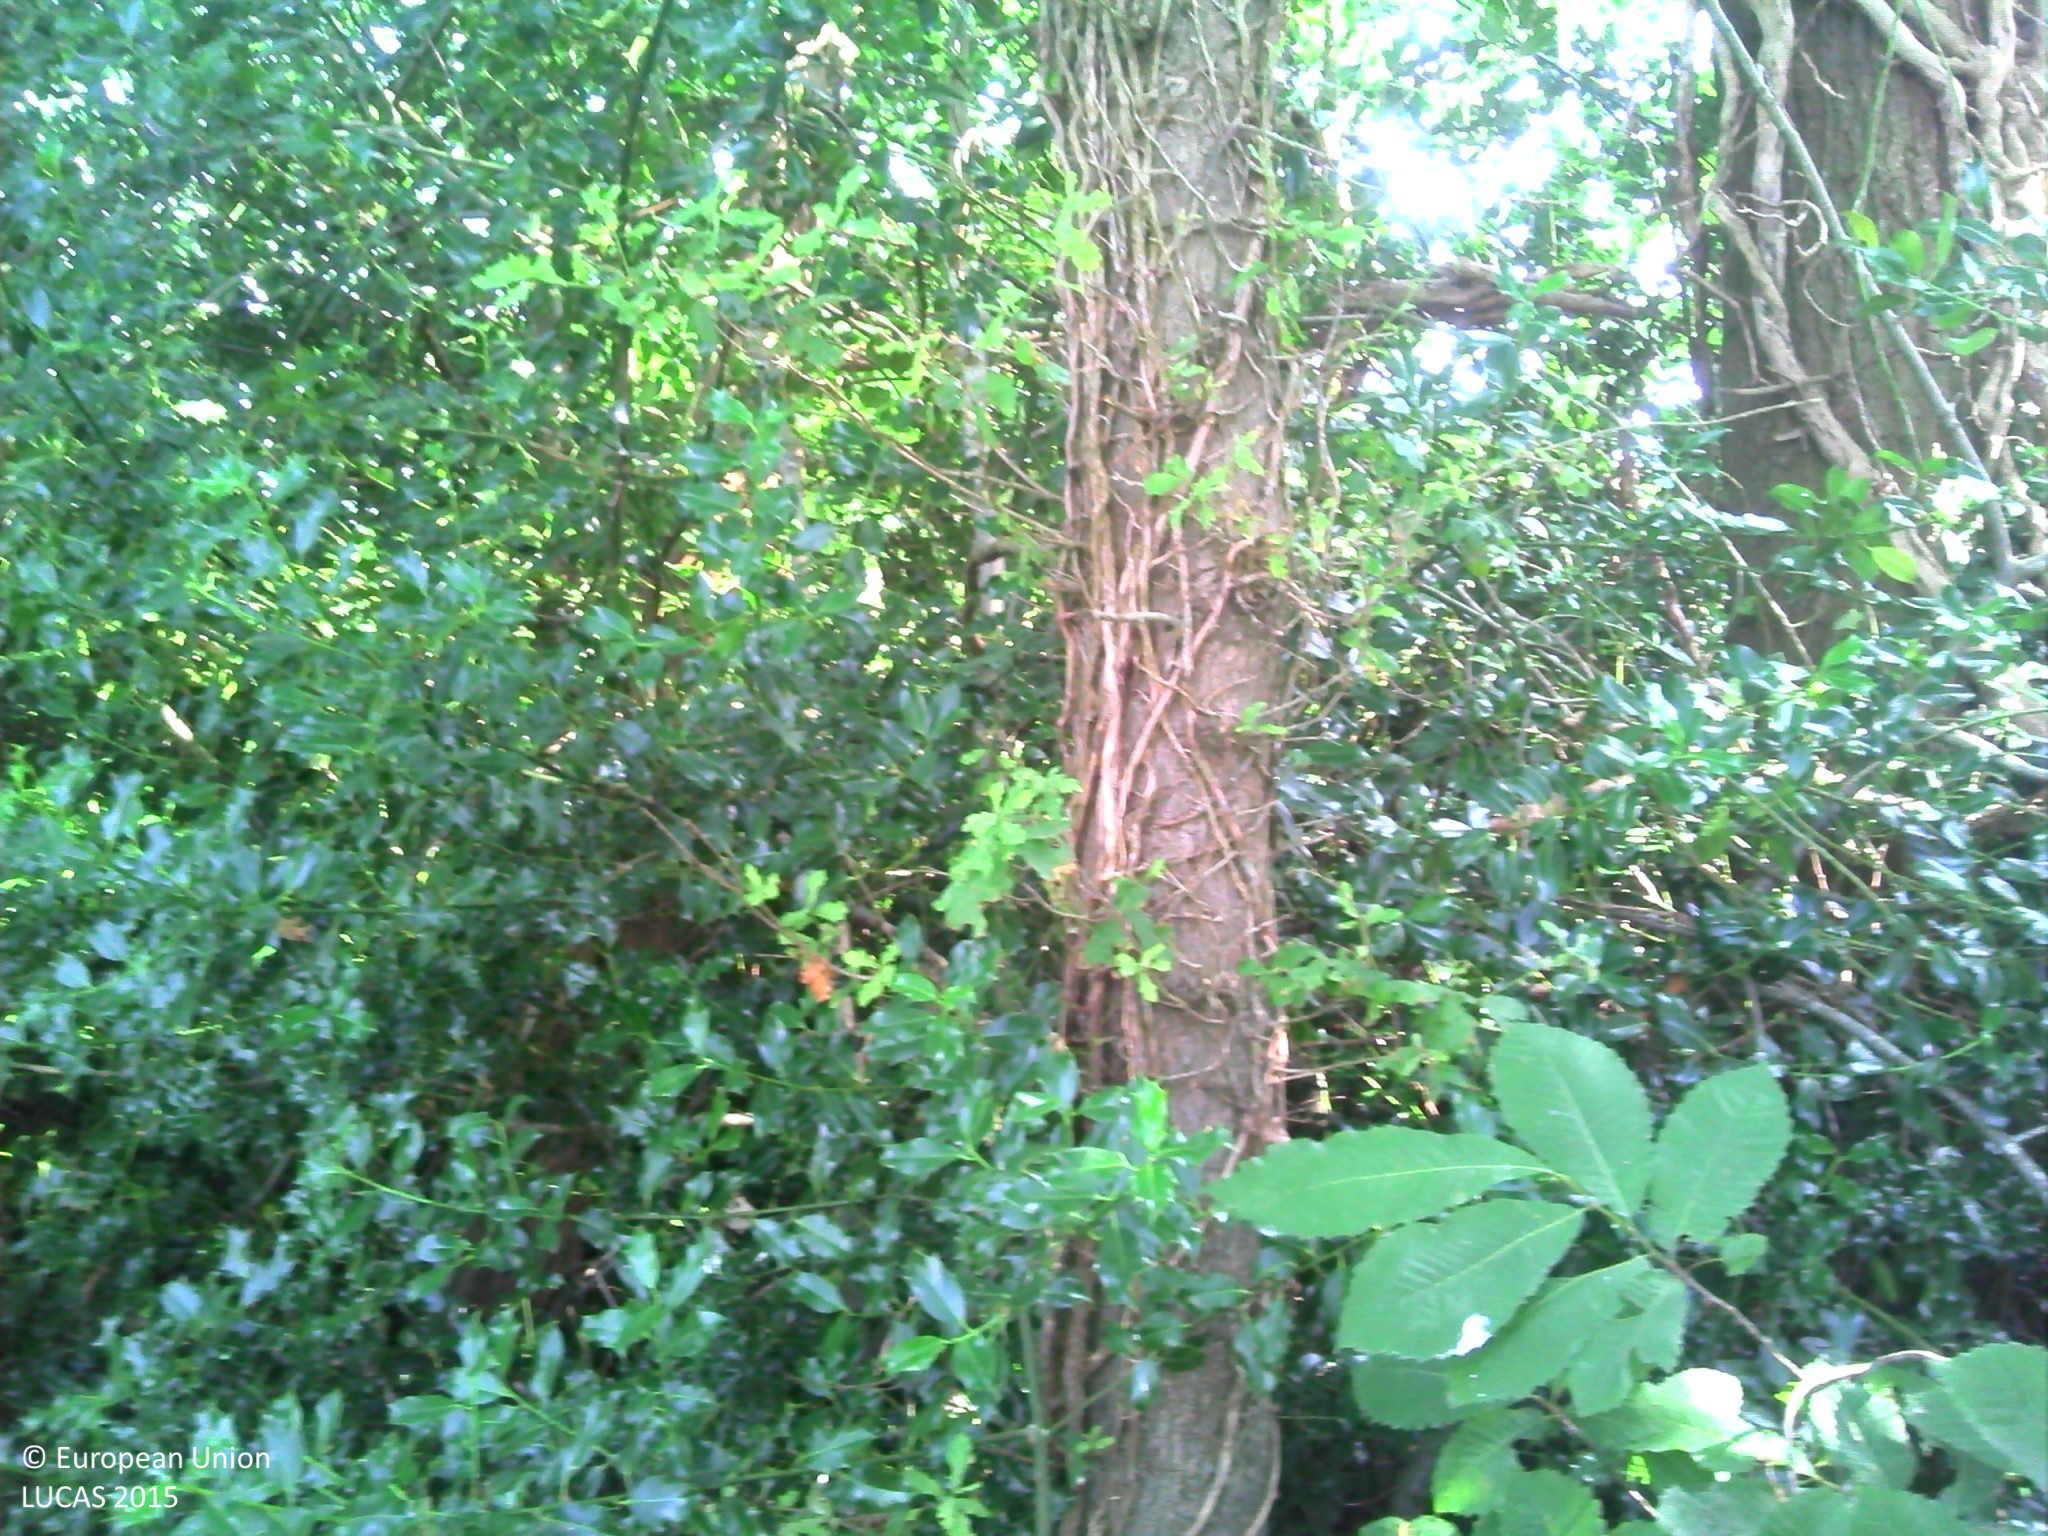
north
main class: Artificial land
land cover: Non built-up linear features
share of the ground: > 75 %
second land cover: Grassland without tree/shrub cover
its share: > 75 %
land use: Road transport
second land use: Agriculture (excluding fallow land and kitchen gardens)
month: July
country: FR
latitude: 47.3229
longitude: -1.8888
